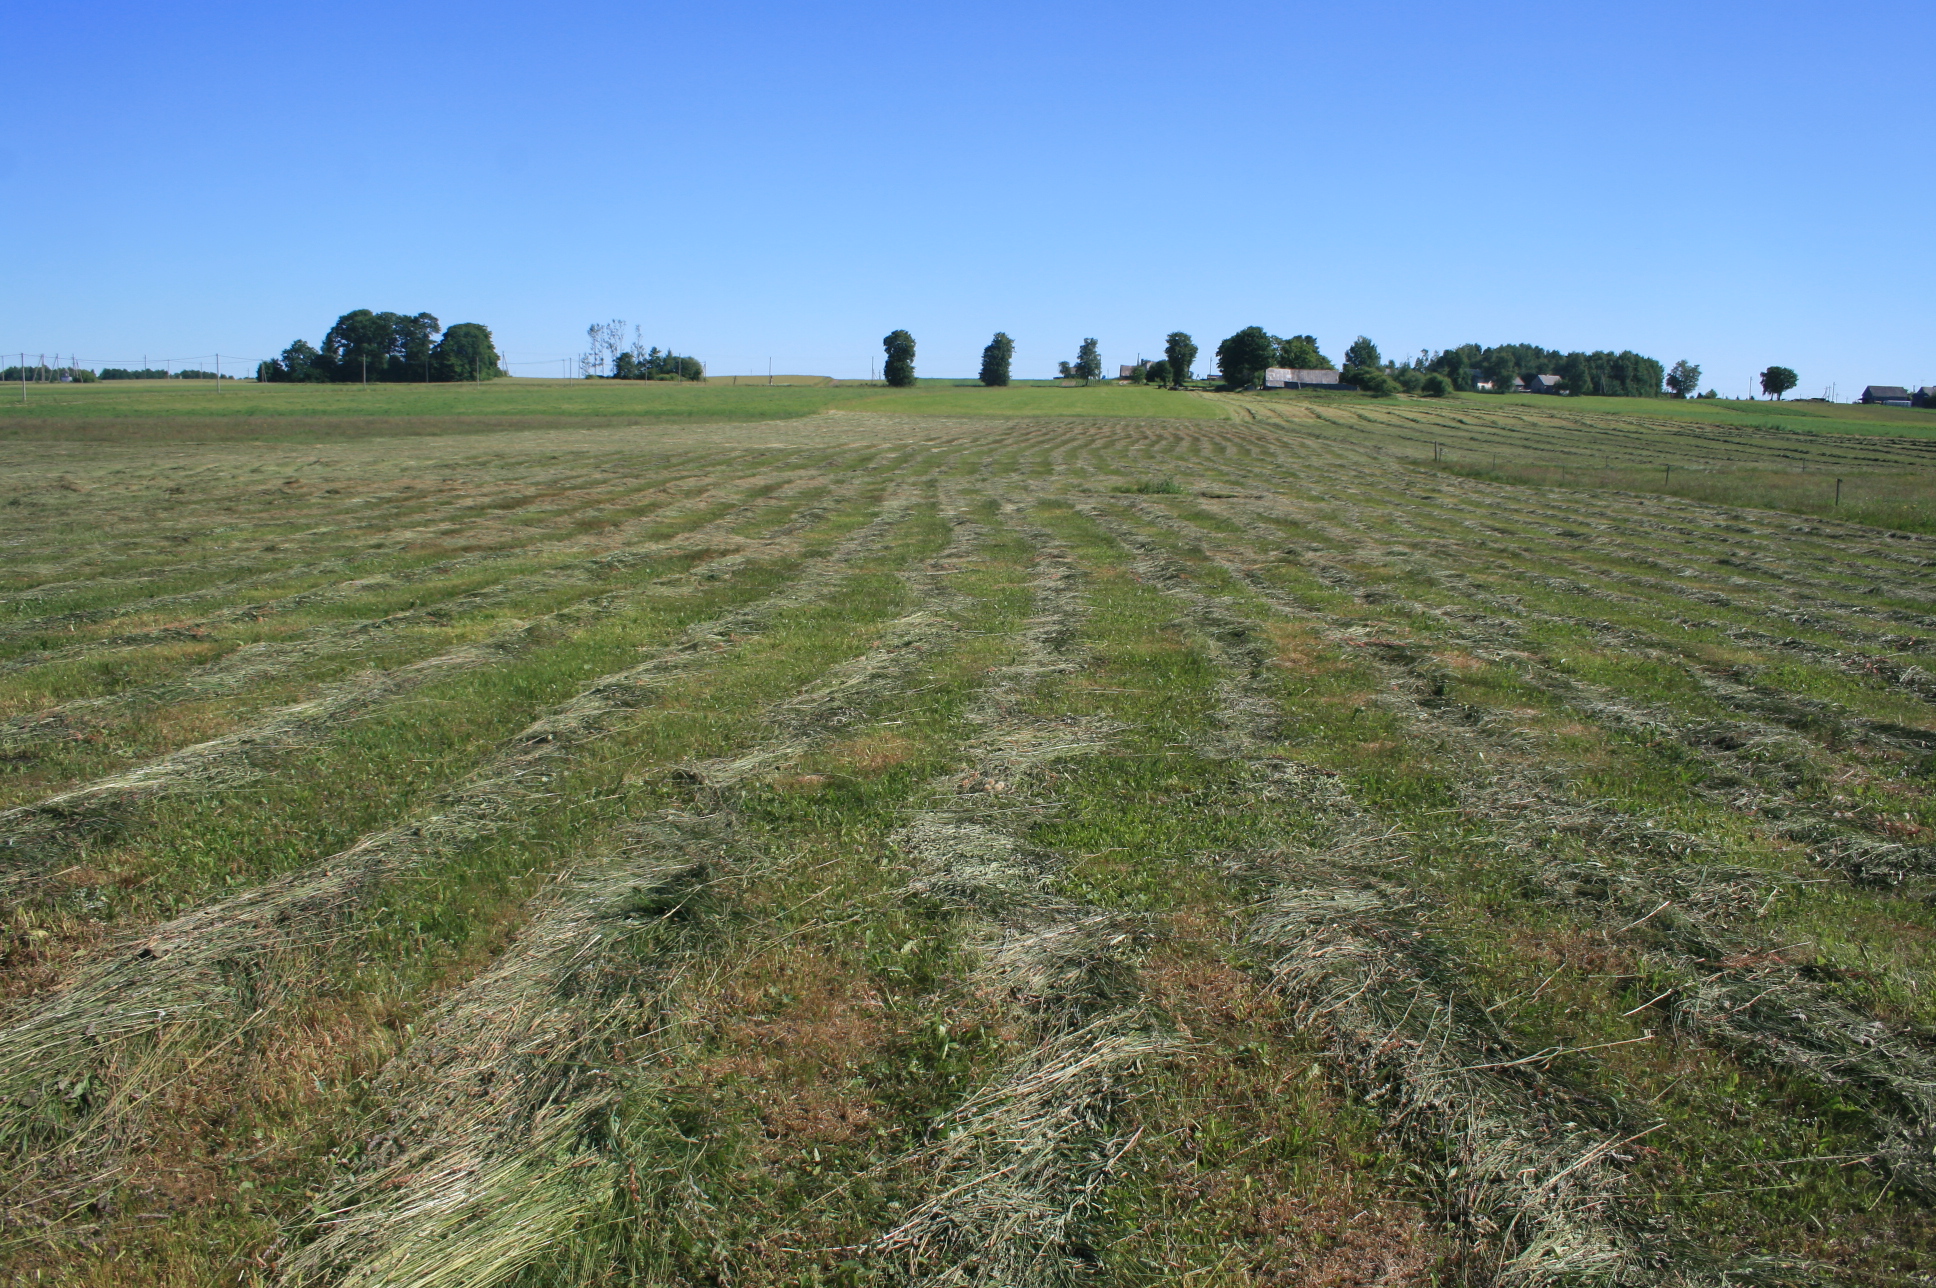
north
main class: Grassland
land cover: Grassland without tree/shrub cover
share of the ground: > 75 %
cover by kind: herbaceous plants 100 %
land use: Agriculture (excluding fallow land and kitchen gardens)
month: June
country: LT
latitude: 55.4648
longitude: 22.1231
